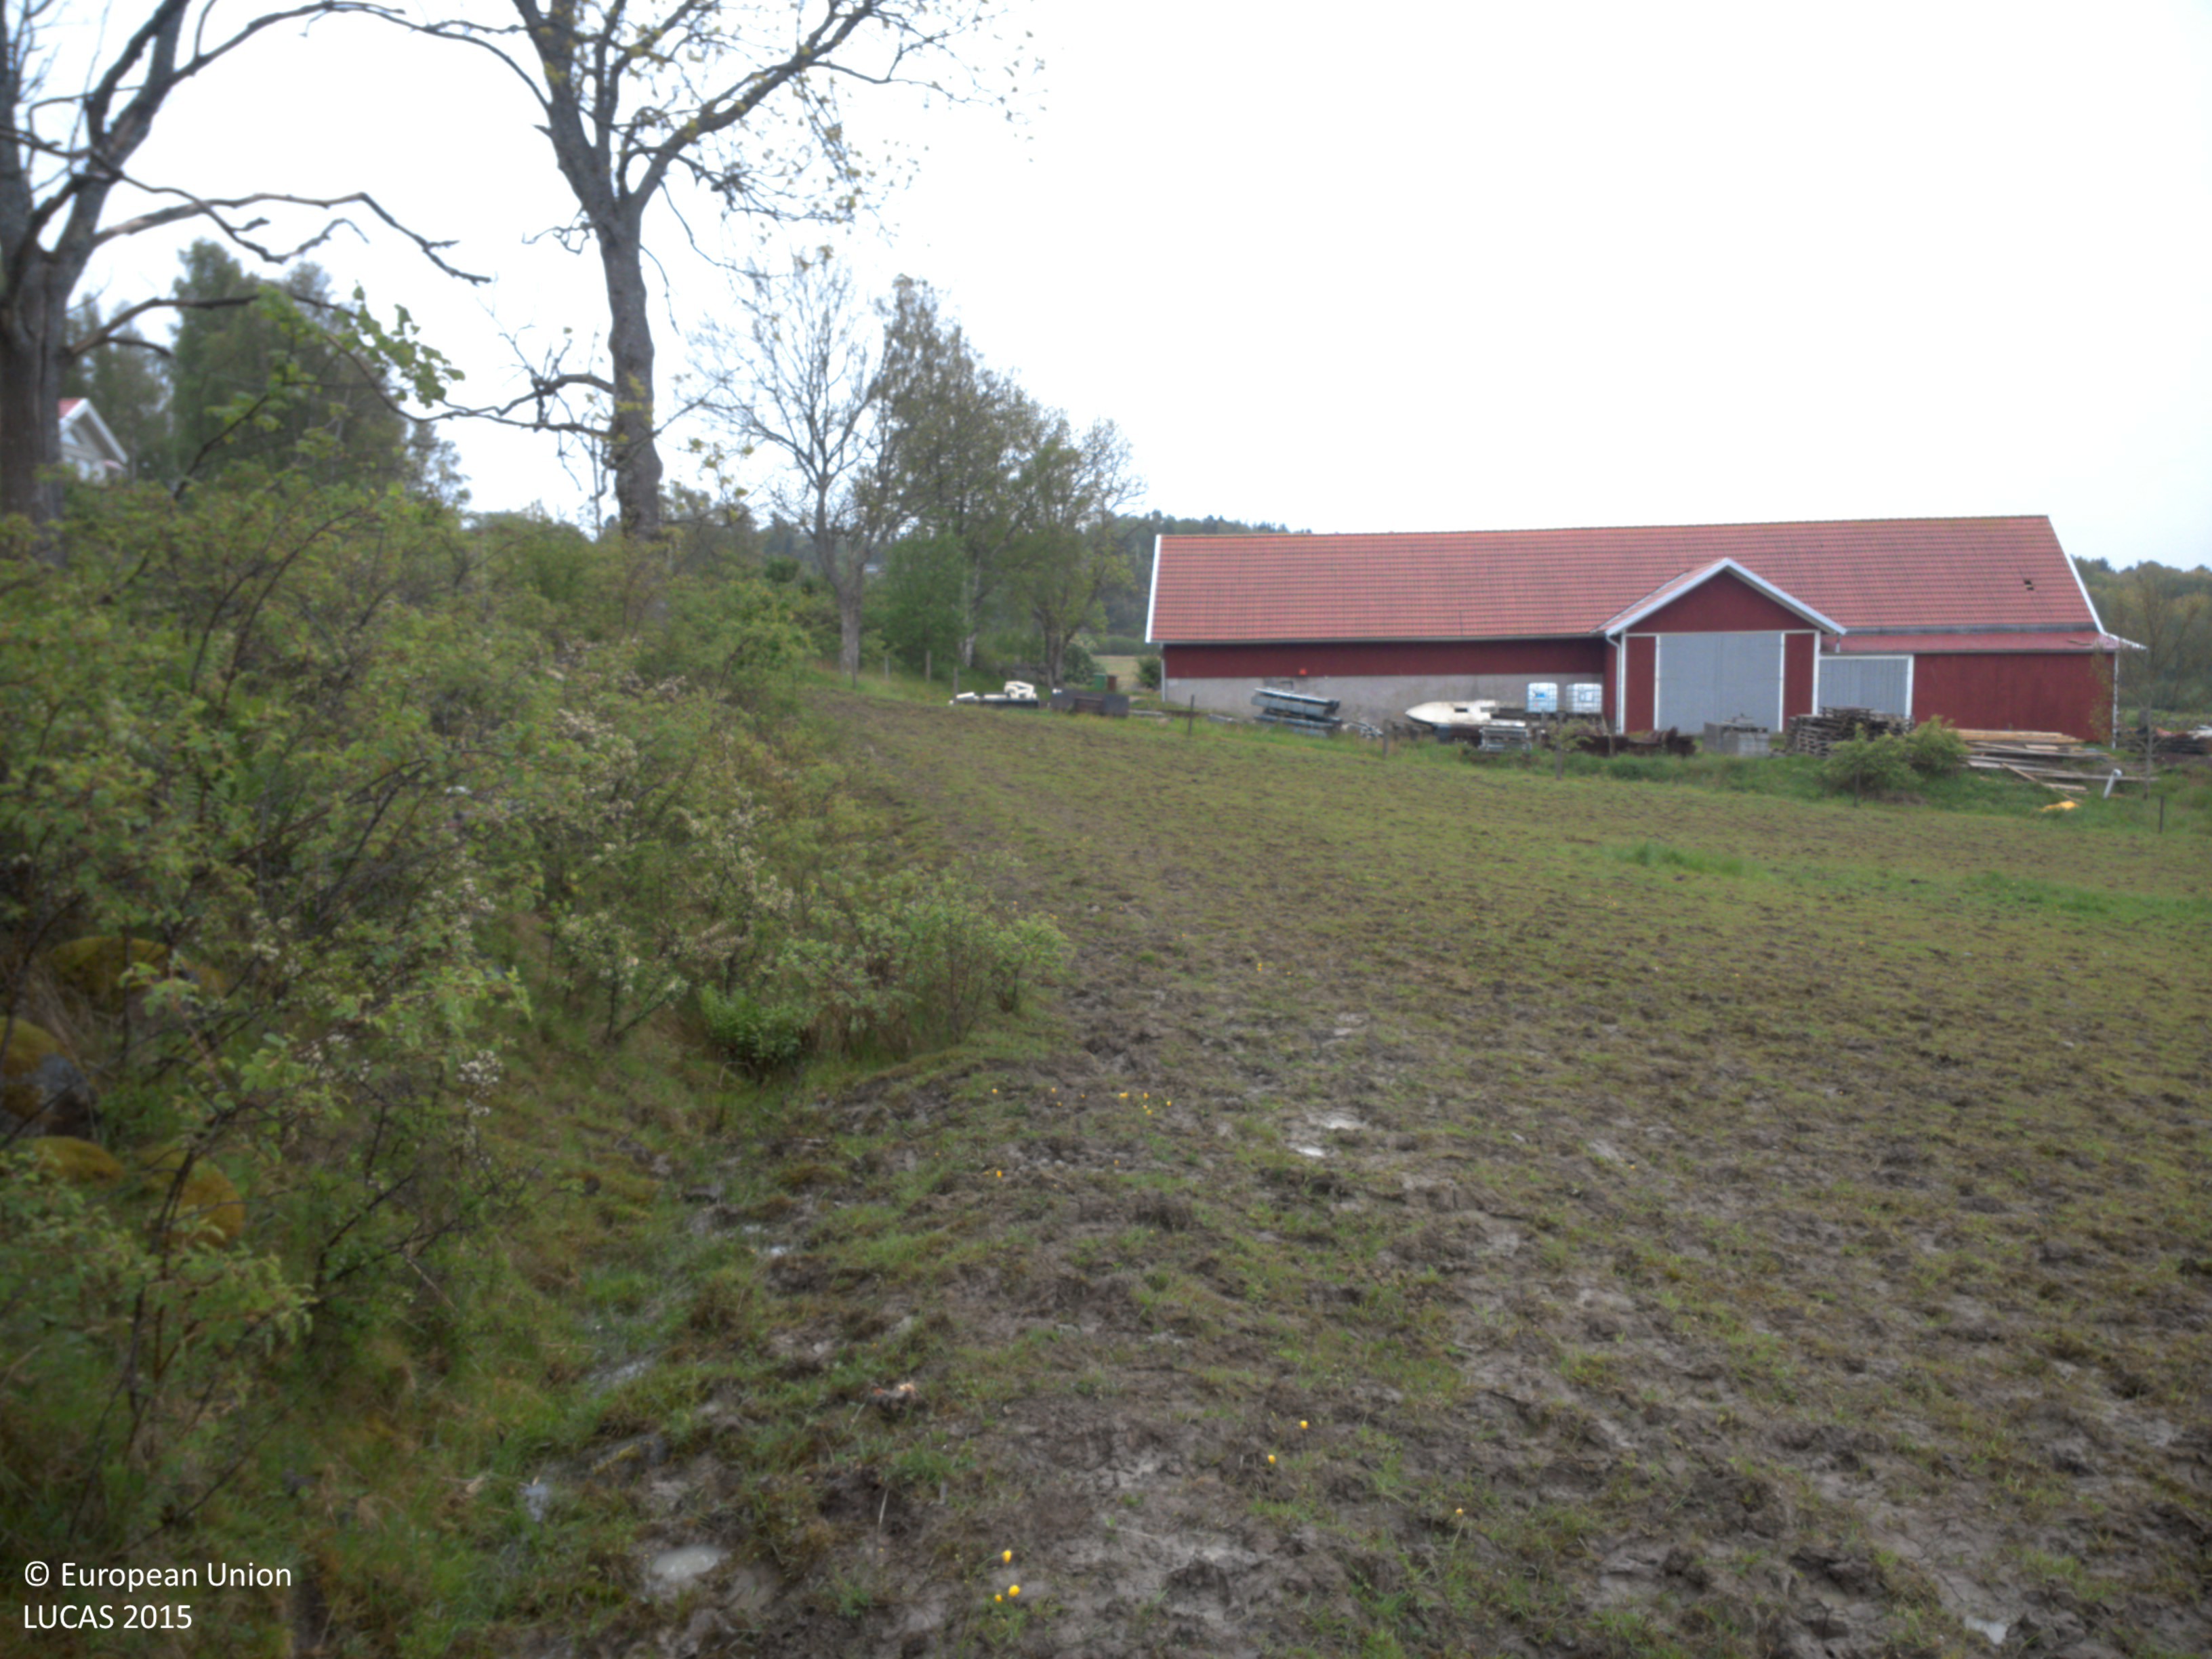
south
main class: Grassland
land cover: Grassland without tree/shrub cover
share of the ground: > 75 %
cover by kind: herbaceous plants 100 %
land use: Agriculture (excluding fallow land and kitchen gardens)
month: May
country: SE
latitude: 58.3361
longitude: 11.5852
